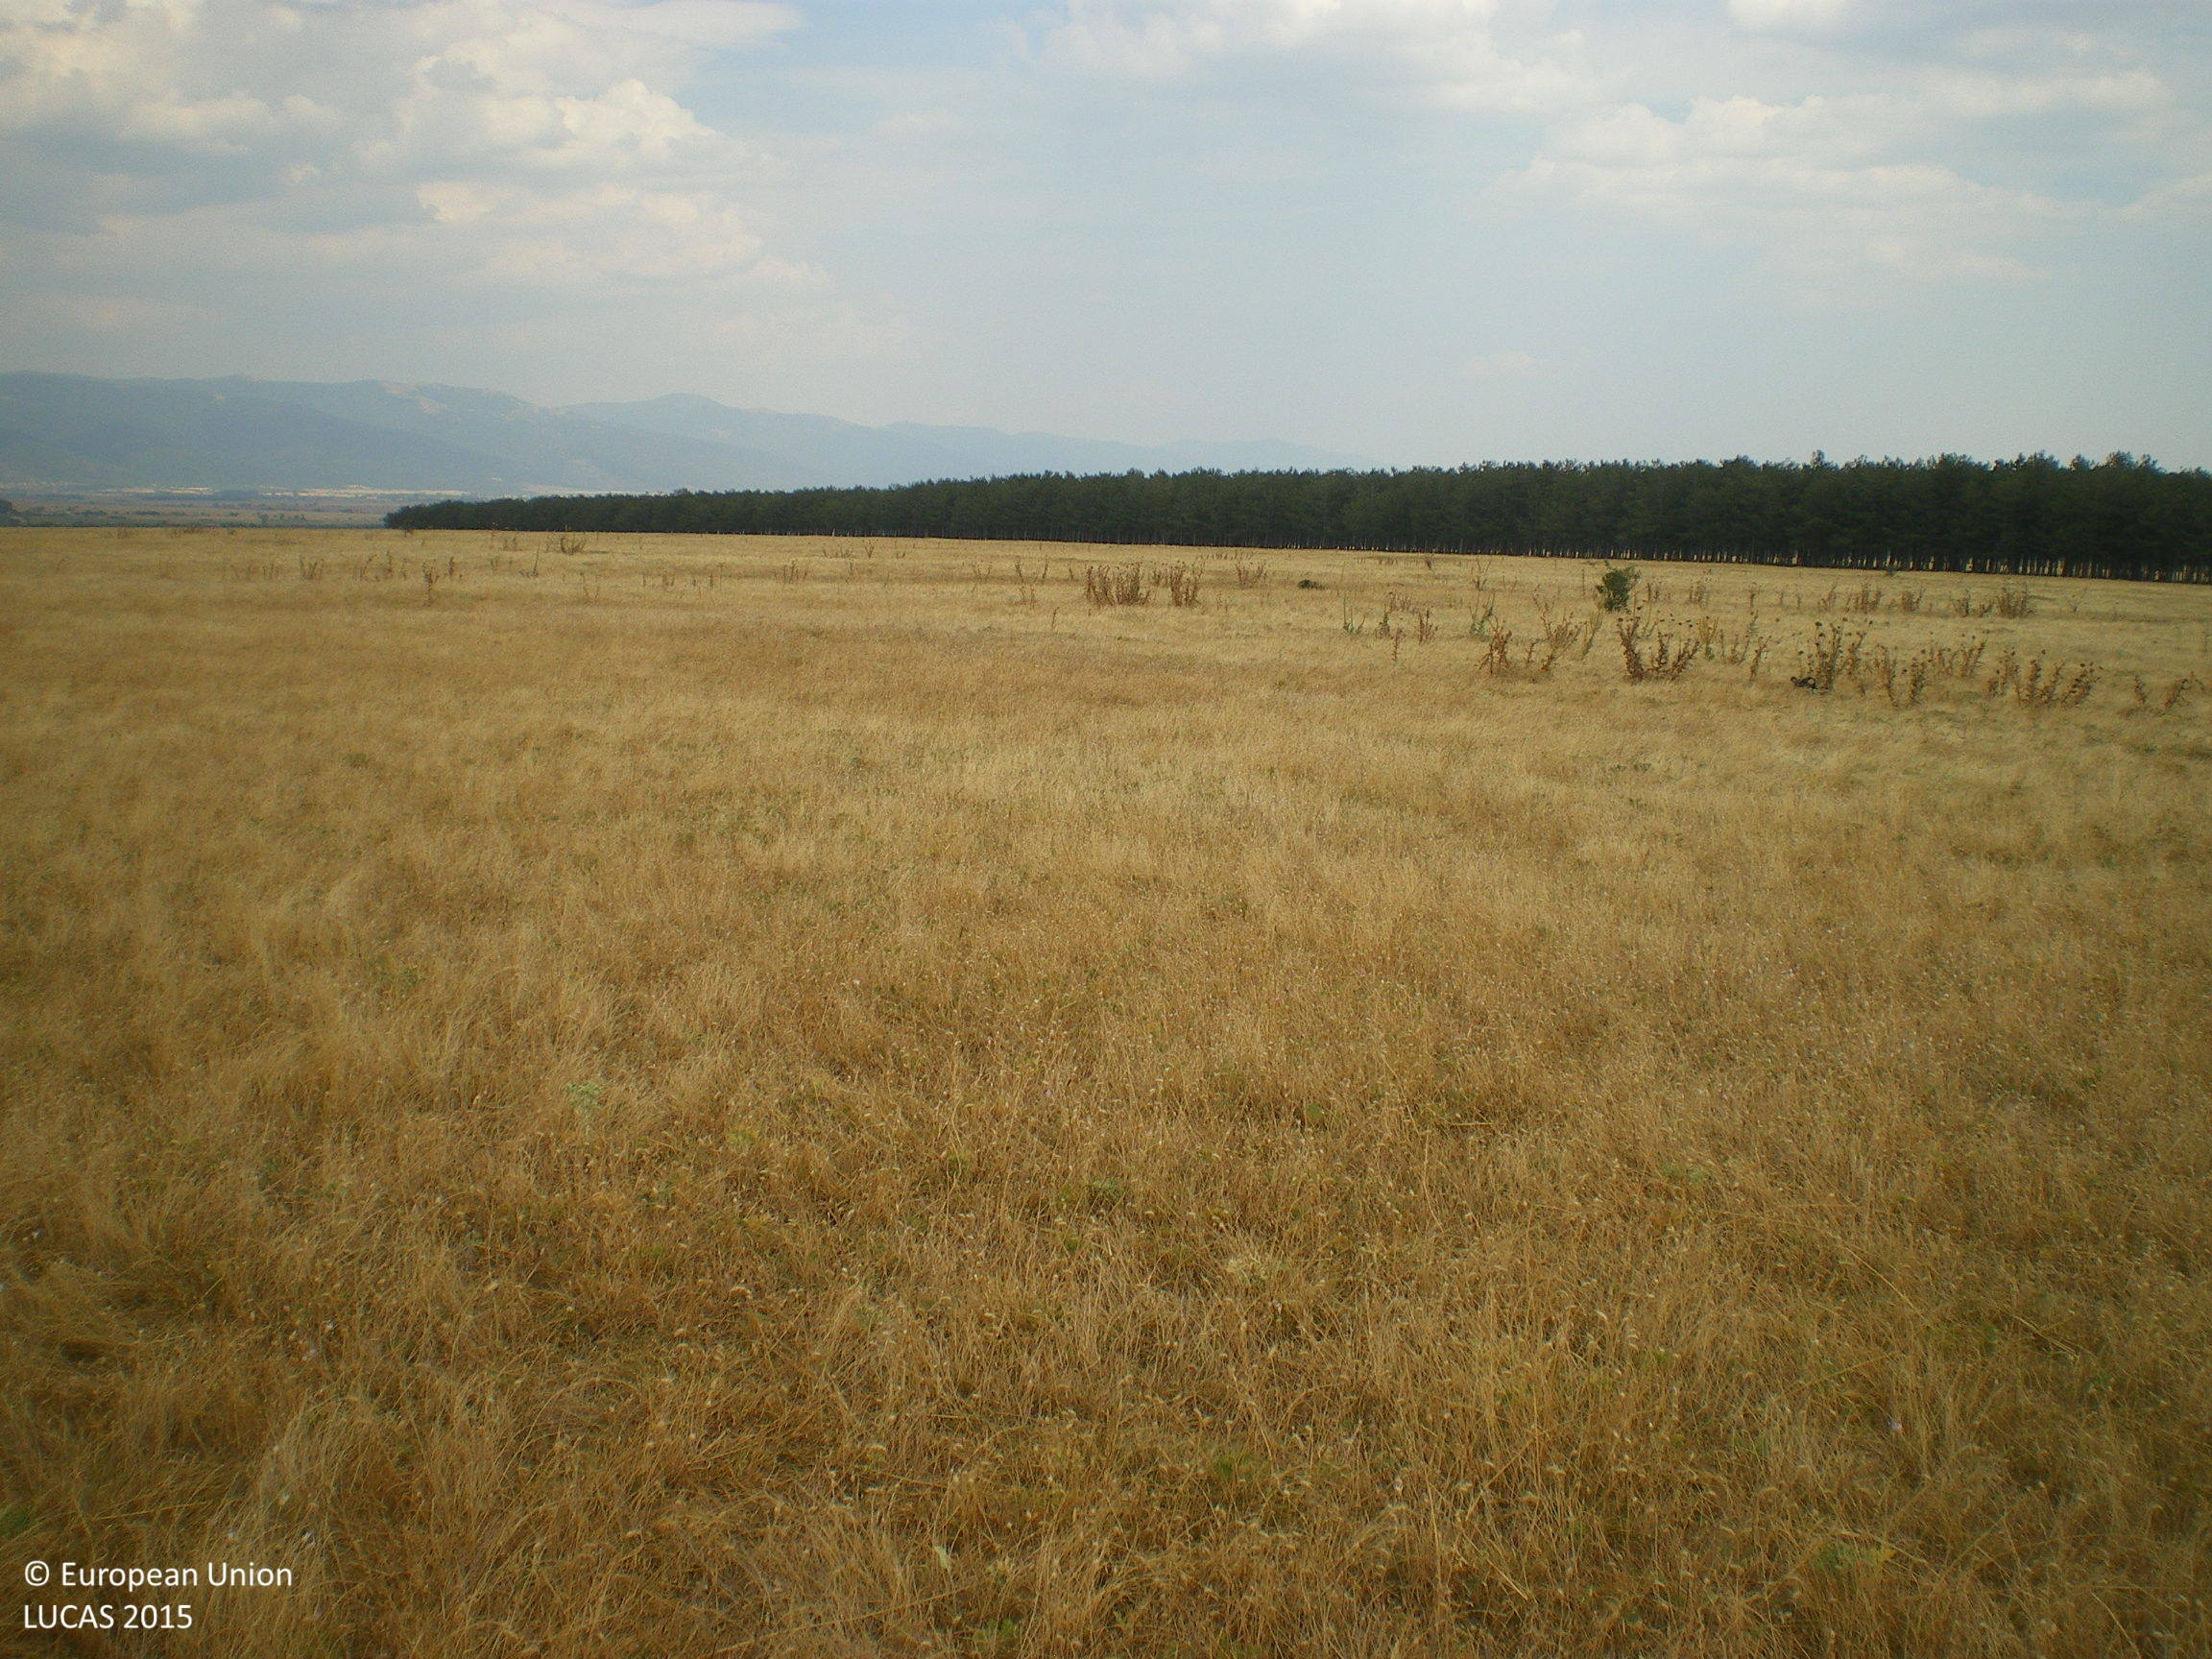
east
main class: Grassland
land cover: Grassland without tree/shrub cover
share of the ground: > 75 %
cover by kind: herbaceous plants 100 %
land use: Agriculture (excluding fallow land and kitchen gardens)
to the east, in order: Grassland without tree/shrub cover
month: July
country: BG
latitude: 42.6716
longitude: 25.2089
